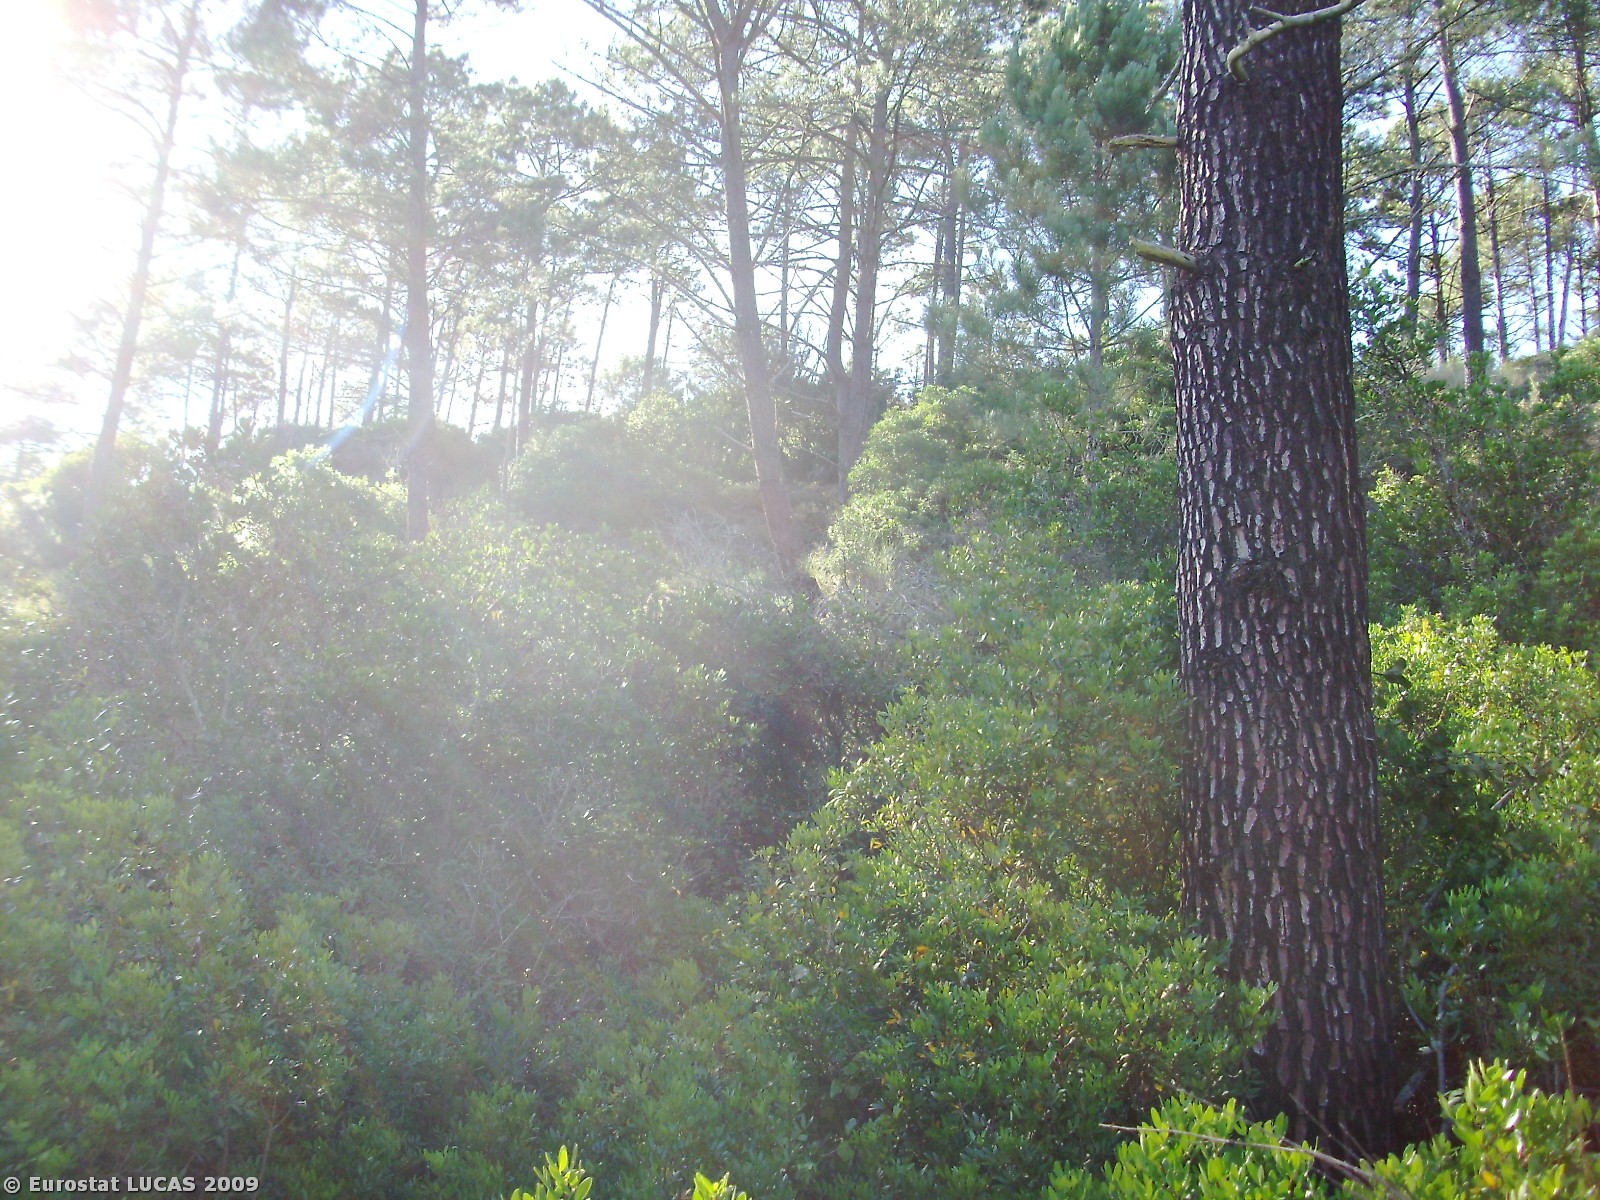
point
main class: Woodland
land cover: Coniferous woodland
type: coniferous forest of the mediterranean region
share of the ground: 50 - 75 %
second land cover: Grassland with sparse tree/shrub cover
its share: 25 - 50 %
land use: Forestry
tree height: > 5 m
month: July
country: PT
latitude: 39.8033
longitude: -8.9783
